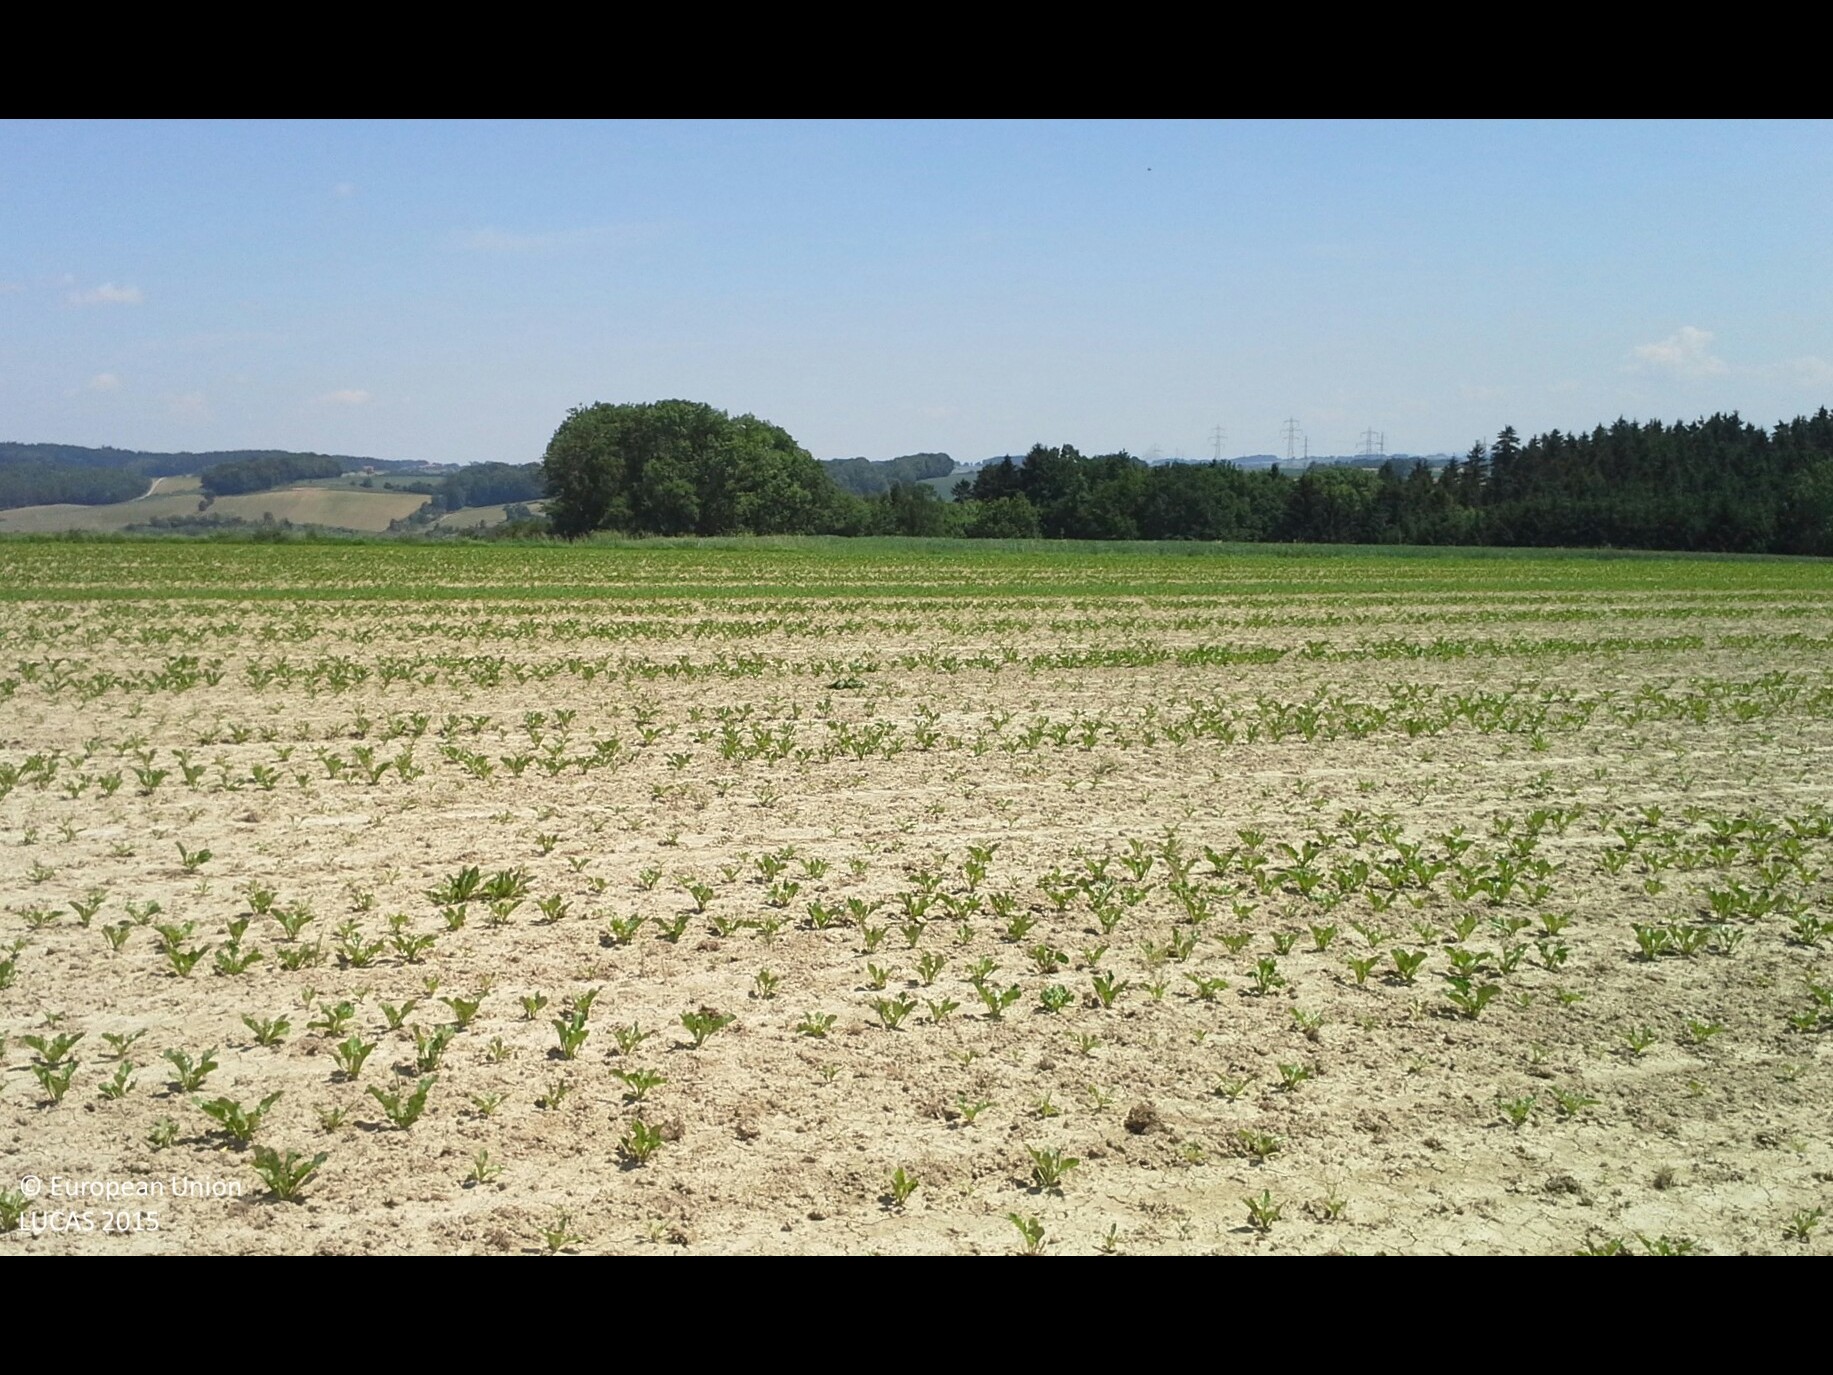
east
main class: Cropland
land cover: Sugar beet
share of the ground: 10 - 25 %
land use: Agriculture (excluding fallow land and kitchen gardens)
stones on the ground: < 10 %
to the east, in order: Sugar beet; Grass margins; Sugar beet; Grass margins; Common wheat; Tracks; Grass margins; Common wheat; Temporary grasslands
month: June
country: AT
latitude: 48.1317
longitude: 14.5015
